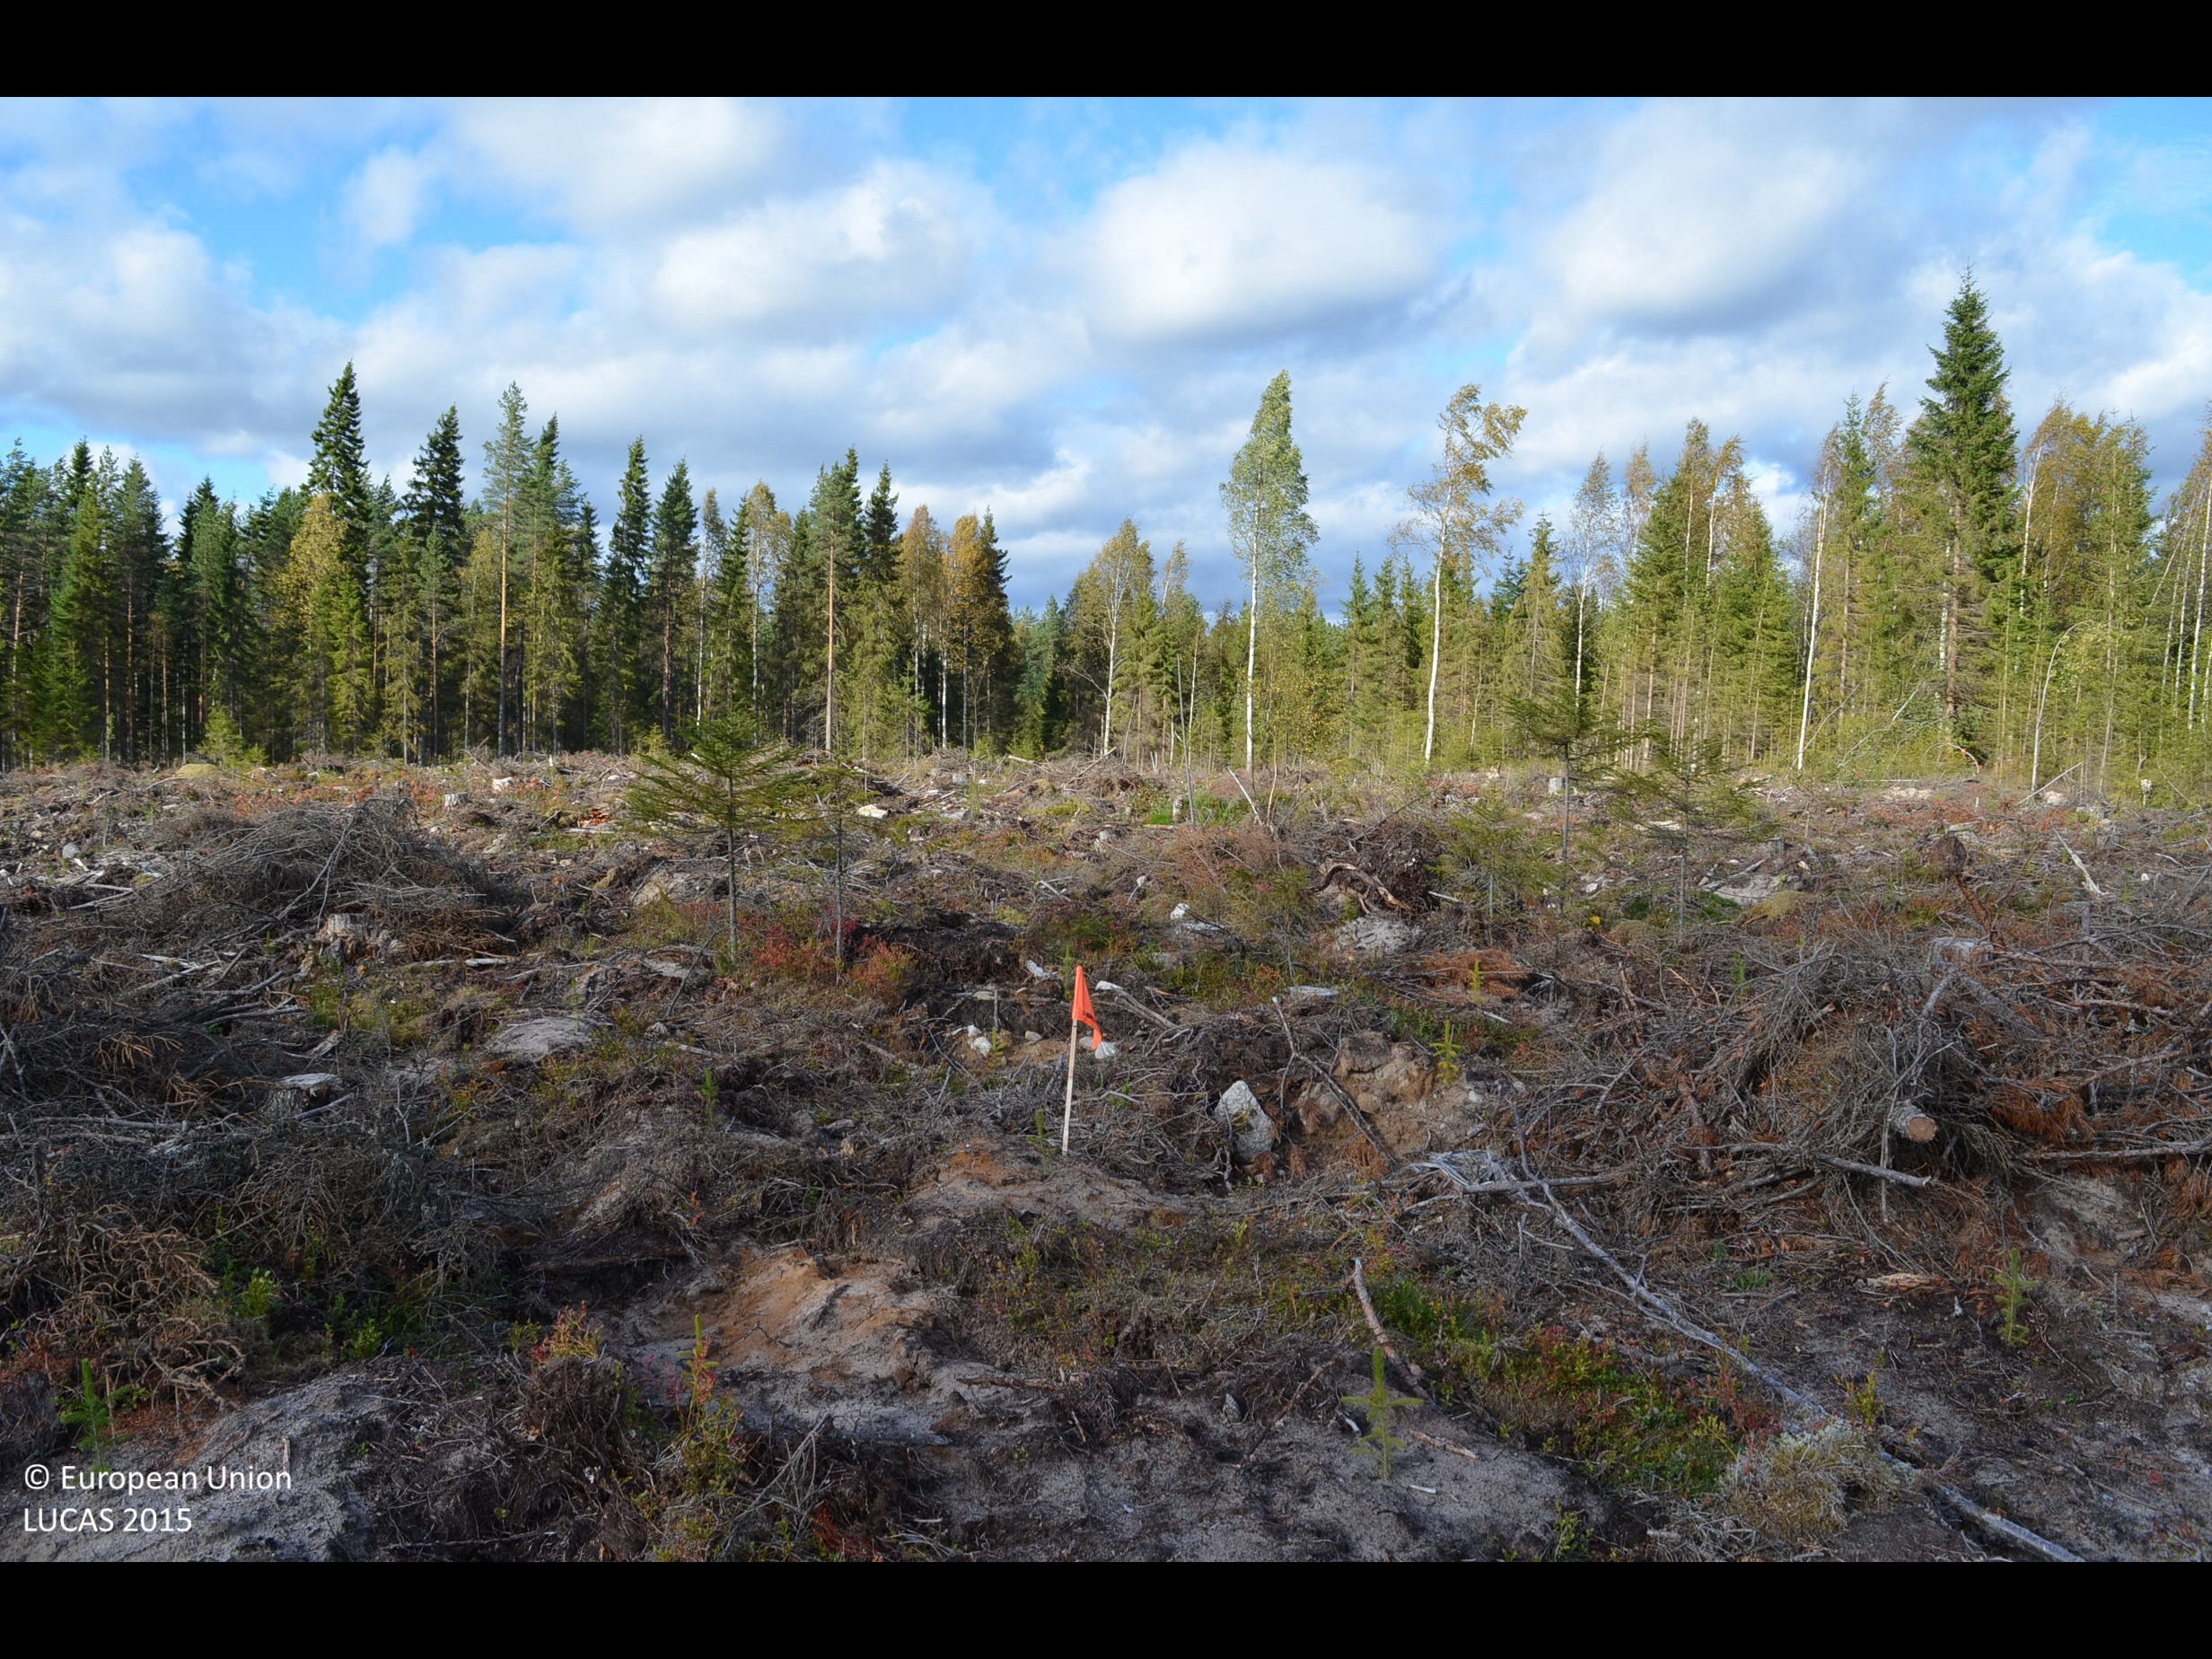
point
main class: Shrubland
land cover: Shrubland without tree cover
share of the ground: 10 - 25 %
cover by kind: unconsolidated bare surface 50 %, shrubs 10 %, lichens and mosses 10 %
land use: Forestry
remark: Clear cut
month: September
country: FI
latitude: 62.9066
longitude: 23.8301
